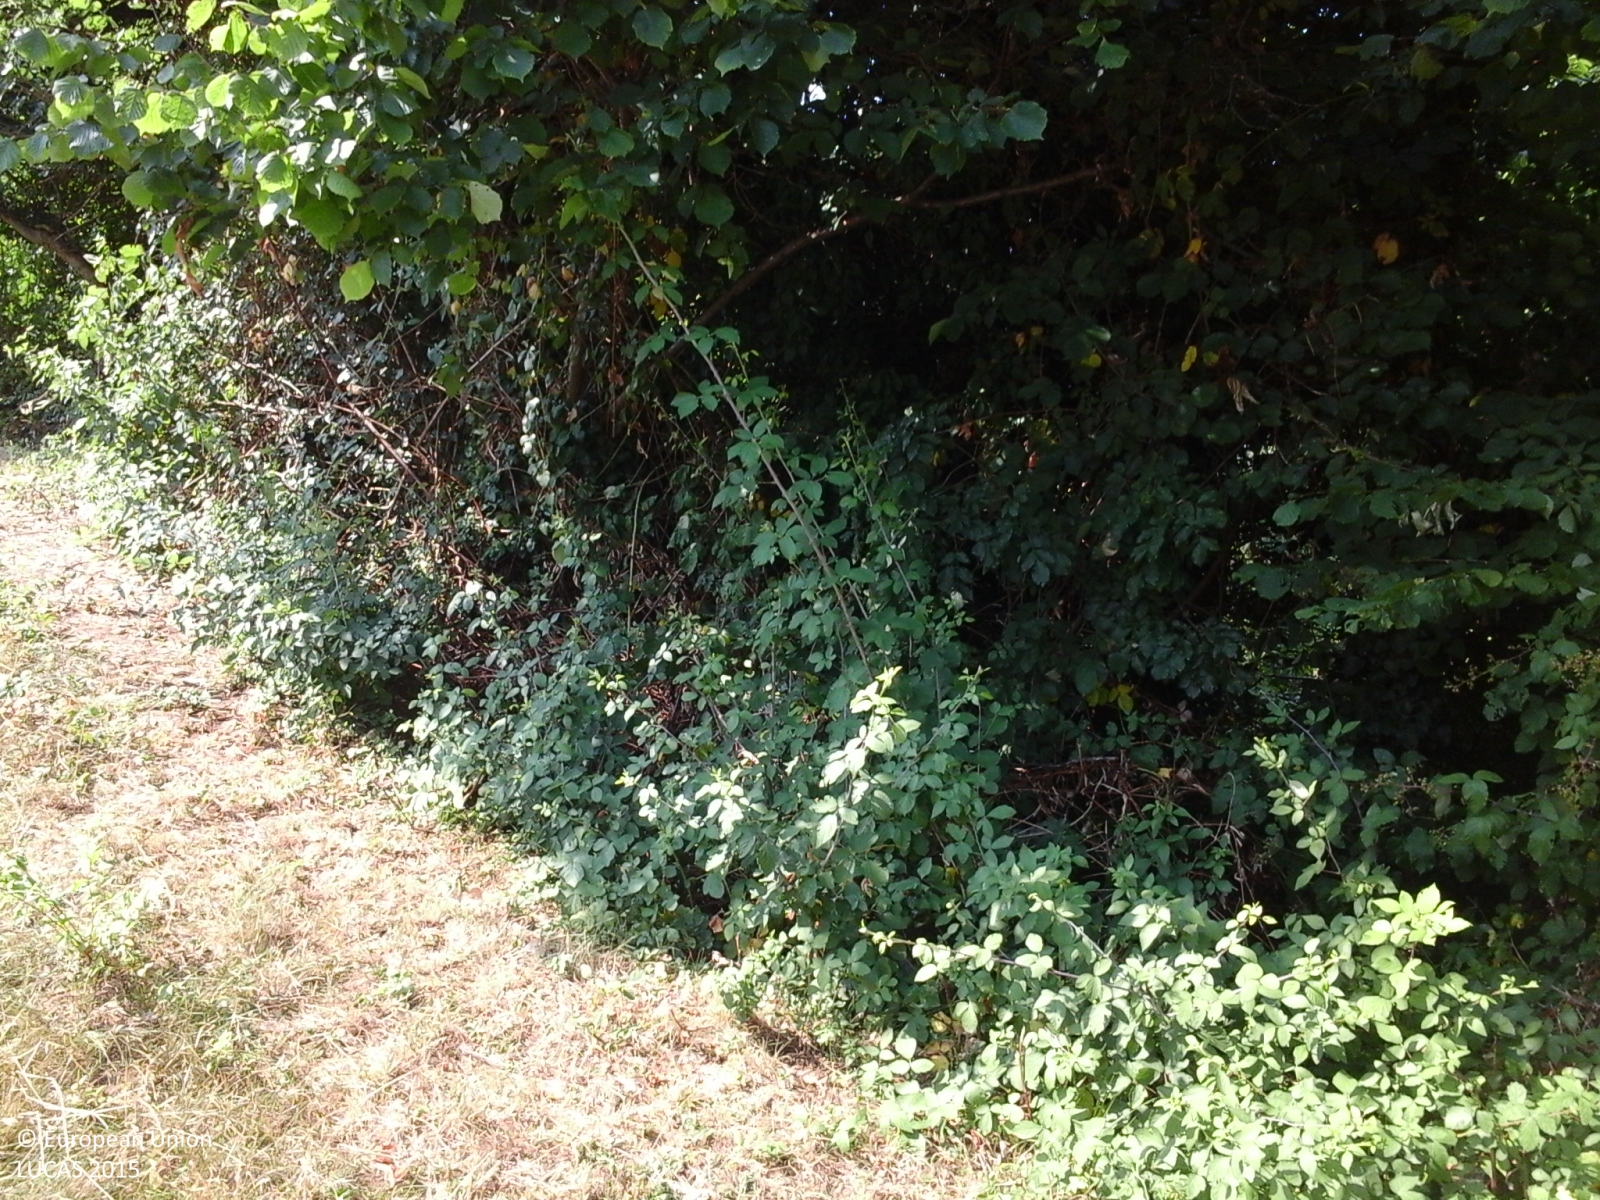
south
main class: Grassland
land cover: Grassland without tree/shrub cover
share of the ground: > 75 %
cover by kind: herbaceous plants 100 %
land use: Agriculture (excluding fallow land and kitchen gardens)
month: July
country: IT
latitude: 45.5346
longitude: 11.1122
